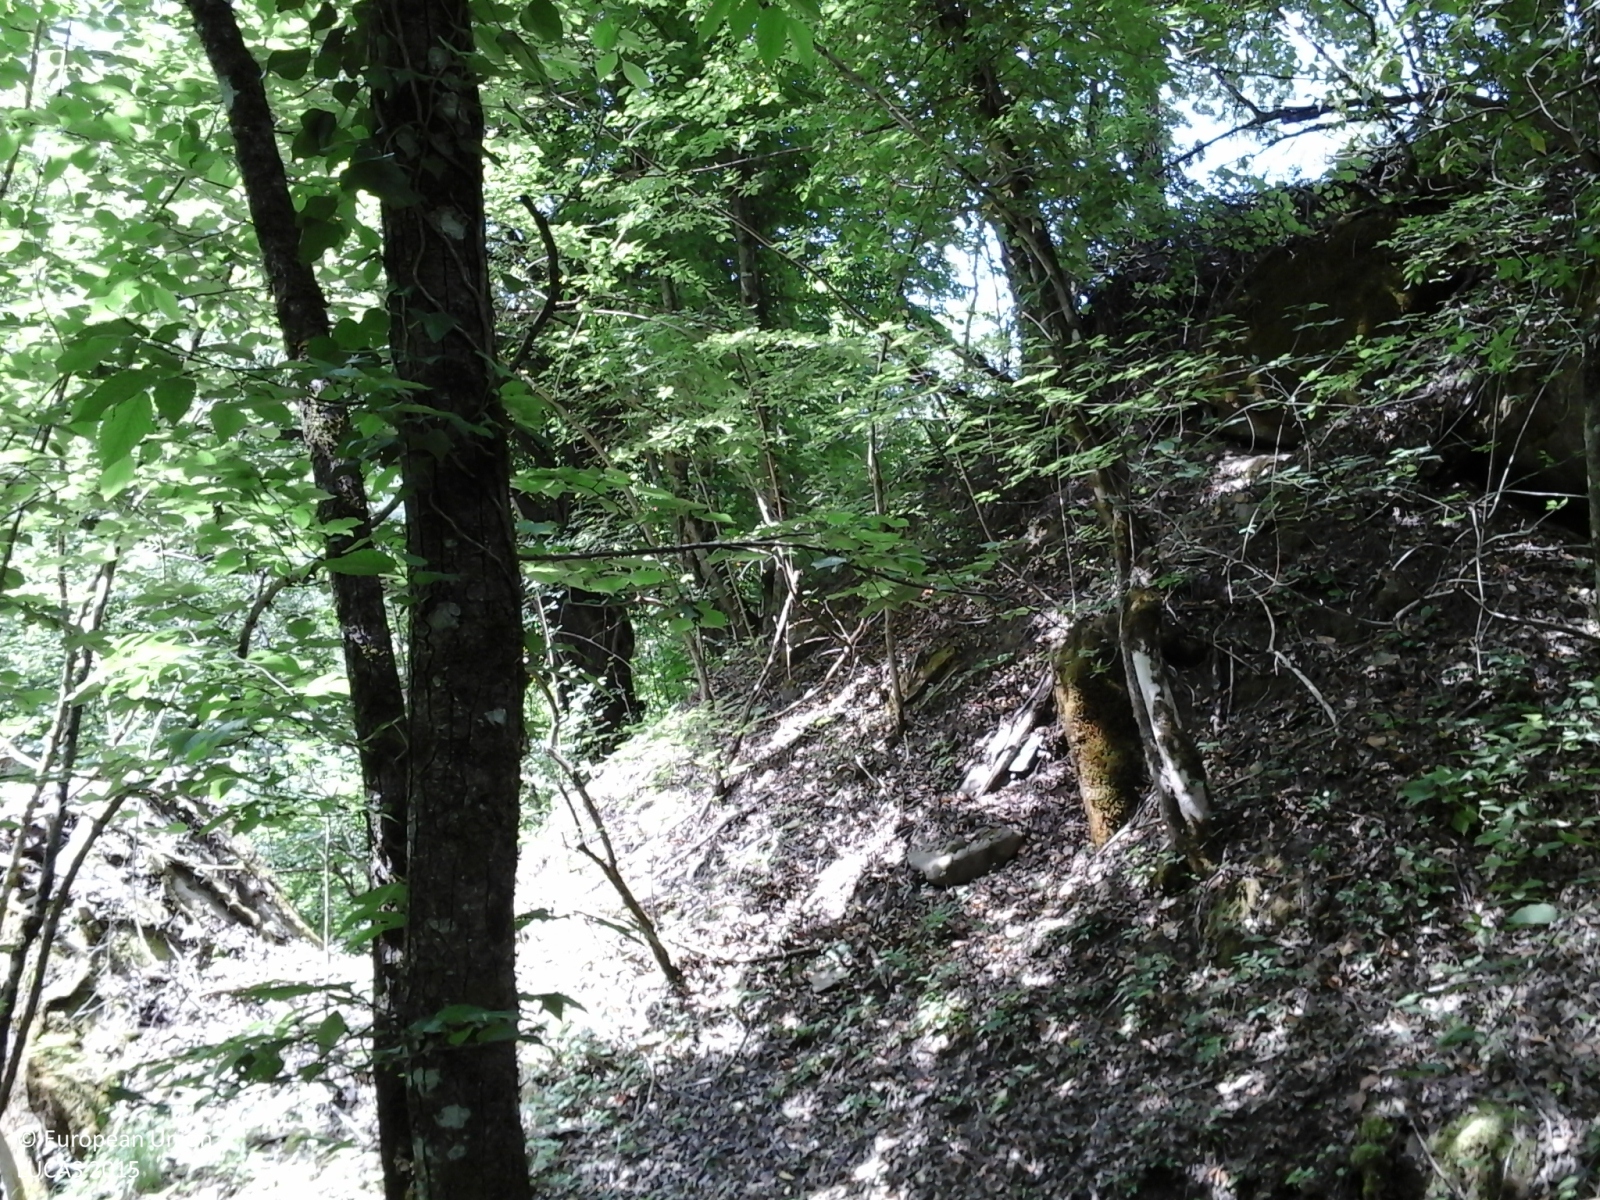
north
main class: Woodland
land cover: Broadleaved woodland
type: thermophilous deciduous forest
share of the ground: > 75 %
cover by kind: broadleaved forest trees 95 %, shrubs 5 %
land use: Semi-natural and natural areas not in use
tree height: > 5 m
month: June
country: IT
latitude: 43.8821
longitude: 11.8996
